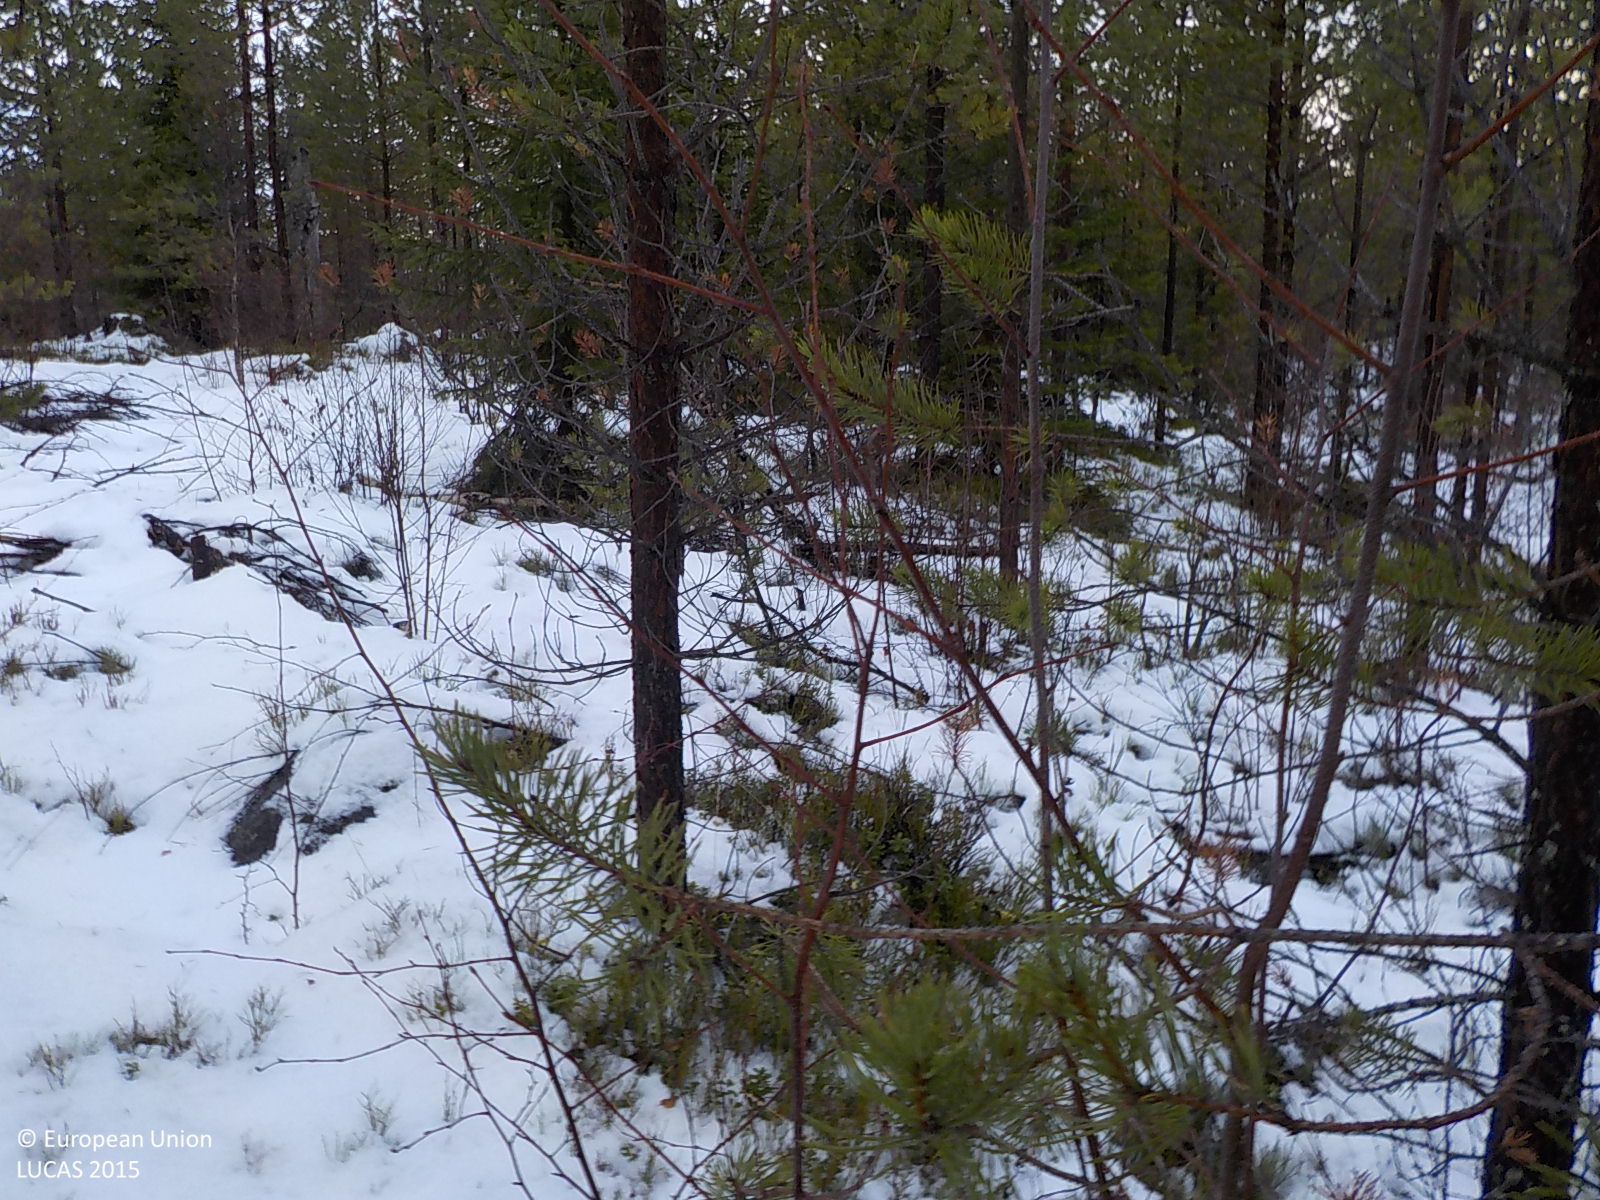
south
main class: Woodland
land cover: Pine dominated coniferous woodland
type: boreal forest
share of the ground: 50 - 75 %
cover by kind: coniferous forest trees 70 %, shrubs 15 %, lichens and mosses 10 %, broadleaved forest trees 5 %
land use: Forestry
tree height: < 5 m
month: December
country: SE
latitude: 63.4595
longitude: 16.6938
